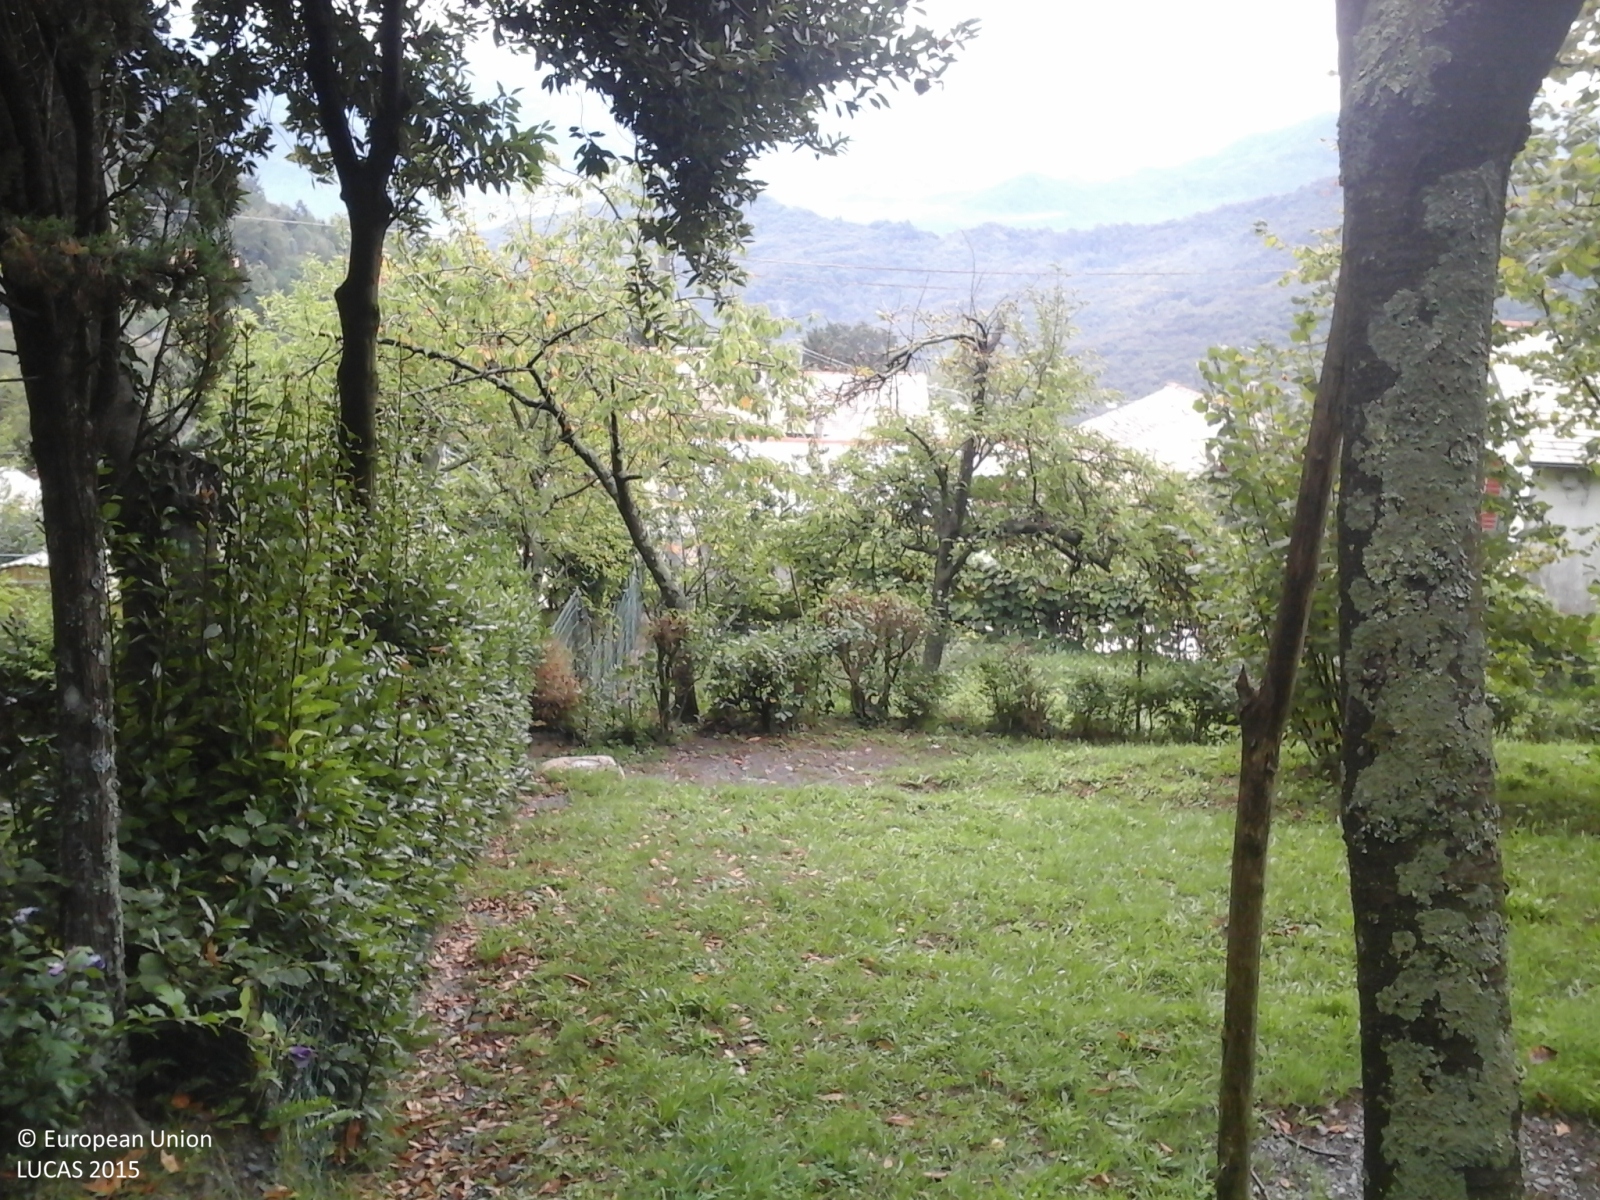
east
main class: Cropland
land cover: Nuts trees
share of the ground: > 75 %
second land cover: Grassland without tree/shrub cover
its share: > 75 %
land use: Agriculture (excluding fallow land and kitchen gardens)
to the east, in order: Nuts trees; Grassland without tree/shrub cover; Artificial constructions in urban areas; Grassland with sparse tree/shrub cover; Other fresh vegetables; Artificial constructions in urban areas; Broadleaved woodland
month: September
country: IT
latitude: 44.4369
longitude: 9.1100
